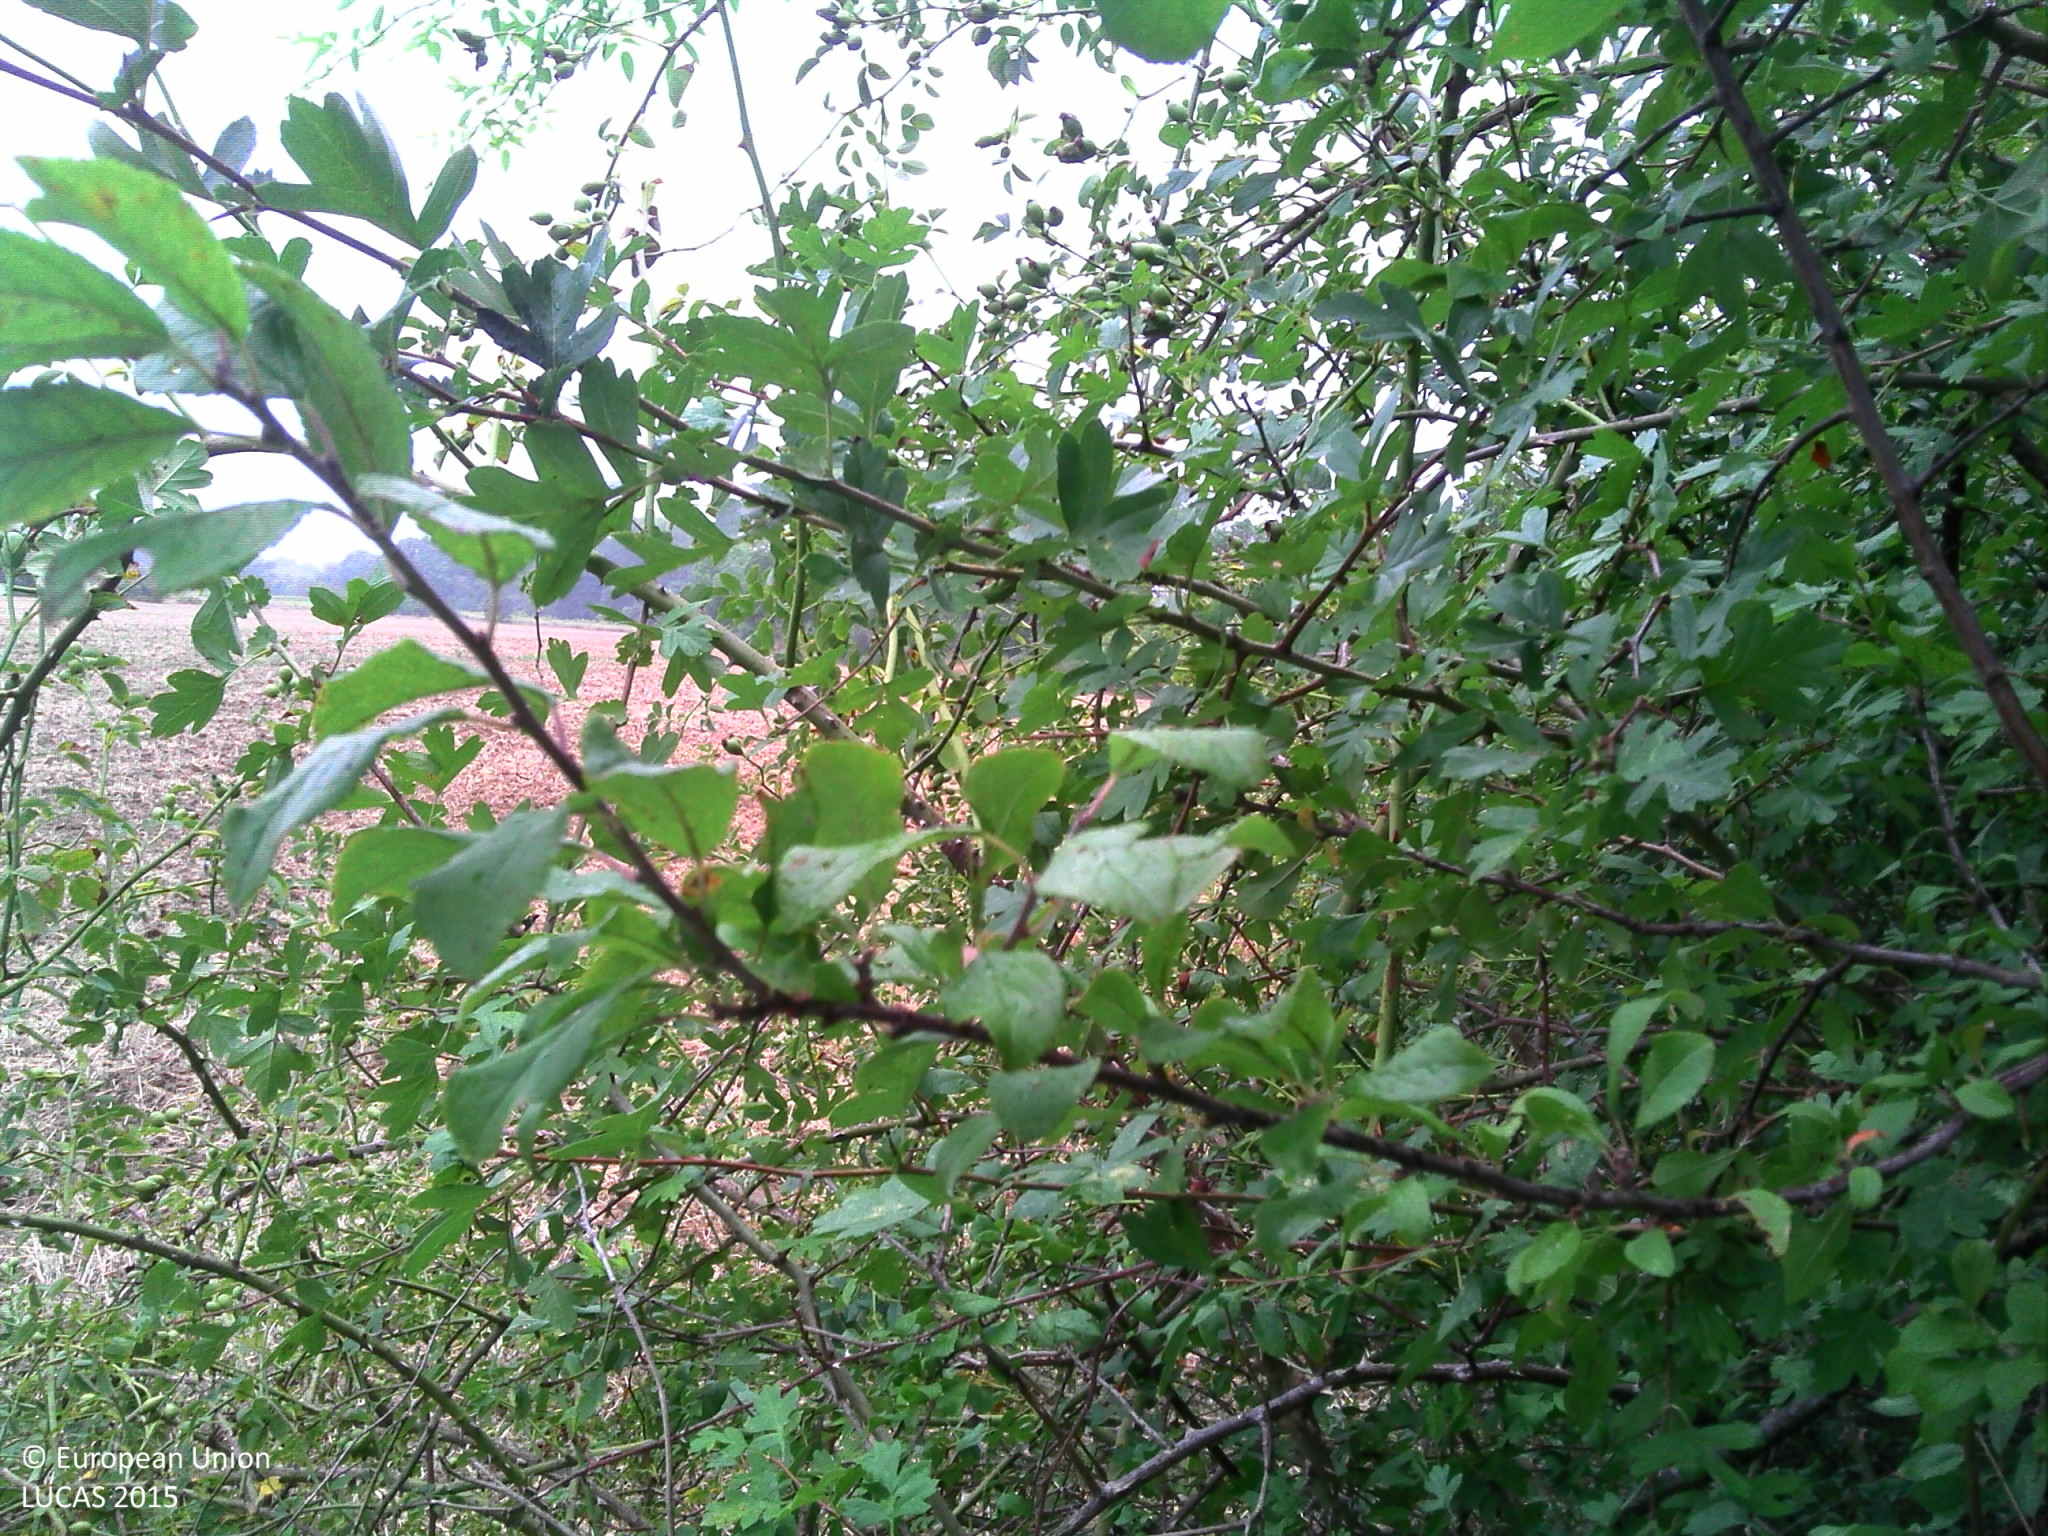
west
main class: Woodland
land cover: Broadleaved woodland
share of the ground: > 75 %
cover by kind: broadleaved forest trees 60 %, shrubs 35 %, herbaceous plants 5 %
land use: Semi-natural and natural areas not in use
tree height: < 5 m
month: July
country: FR
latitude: 44.1280
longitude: 0.8607
